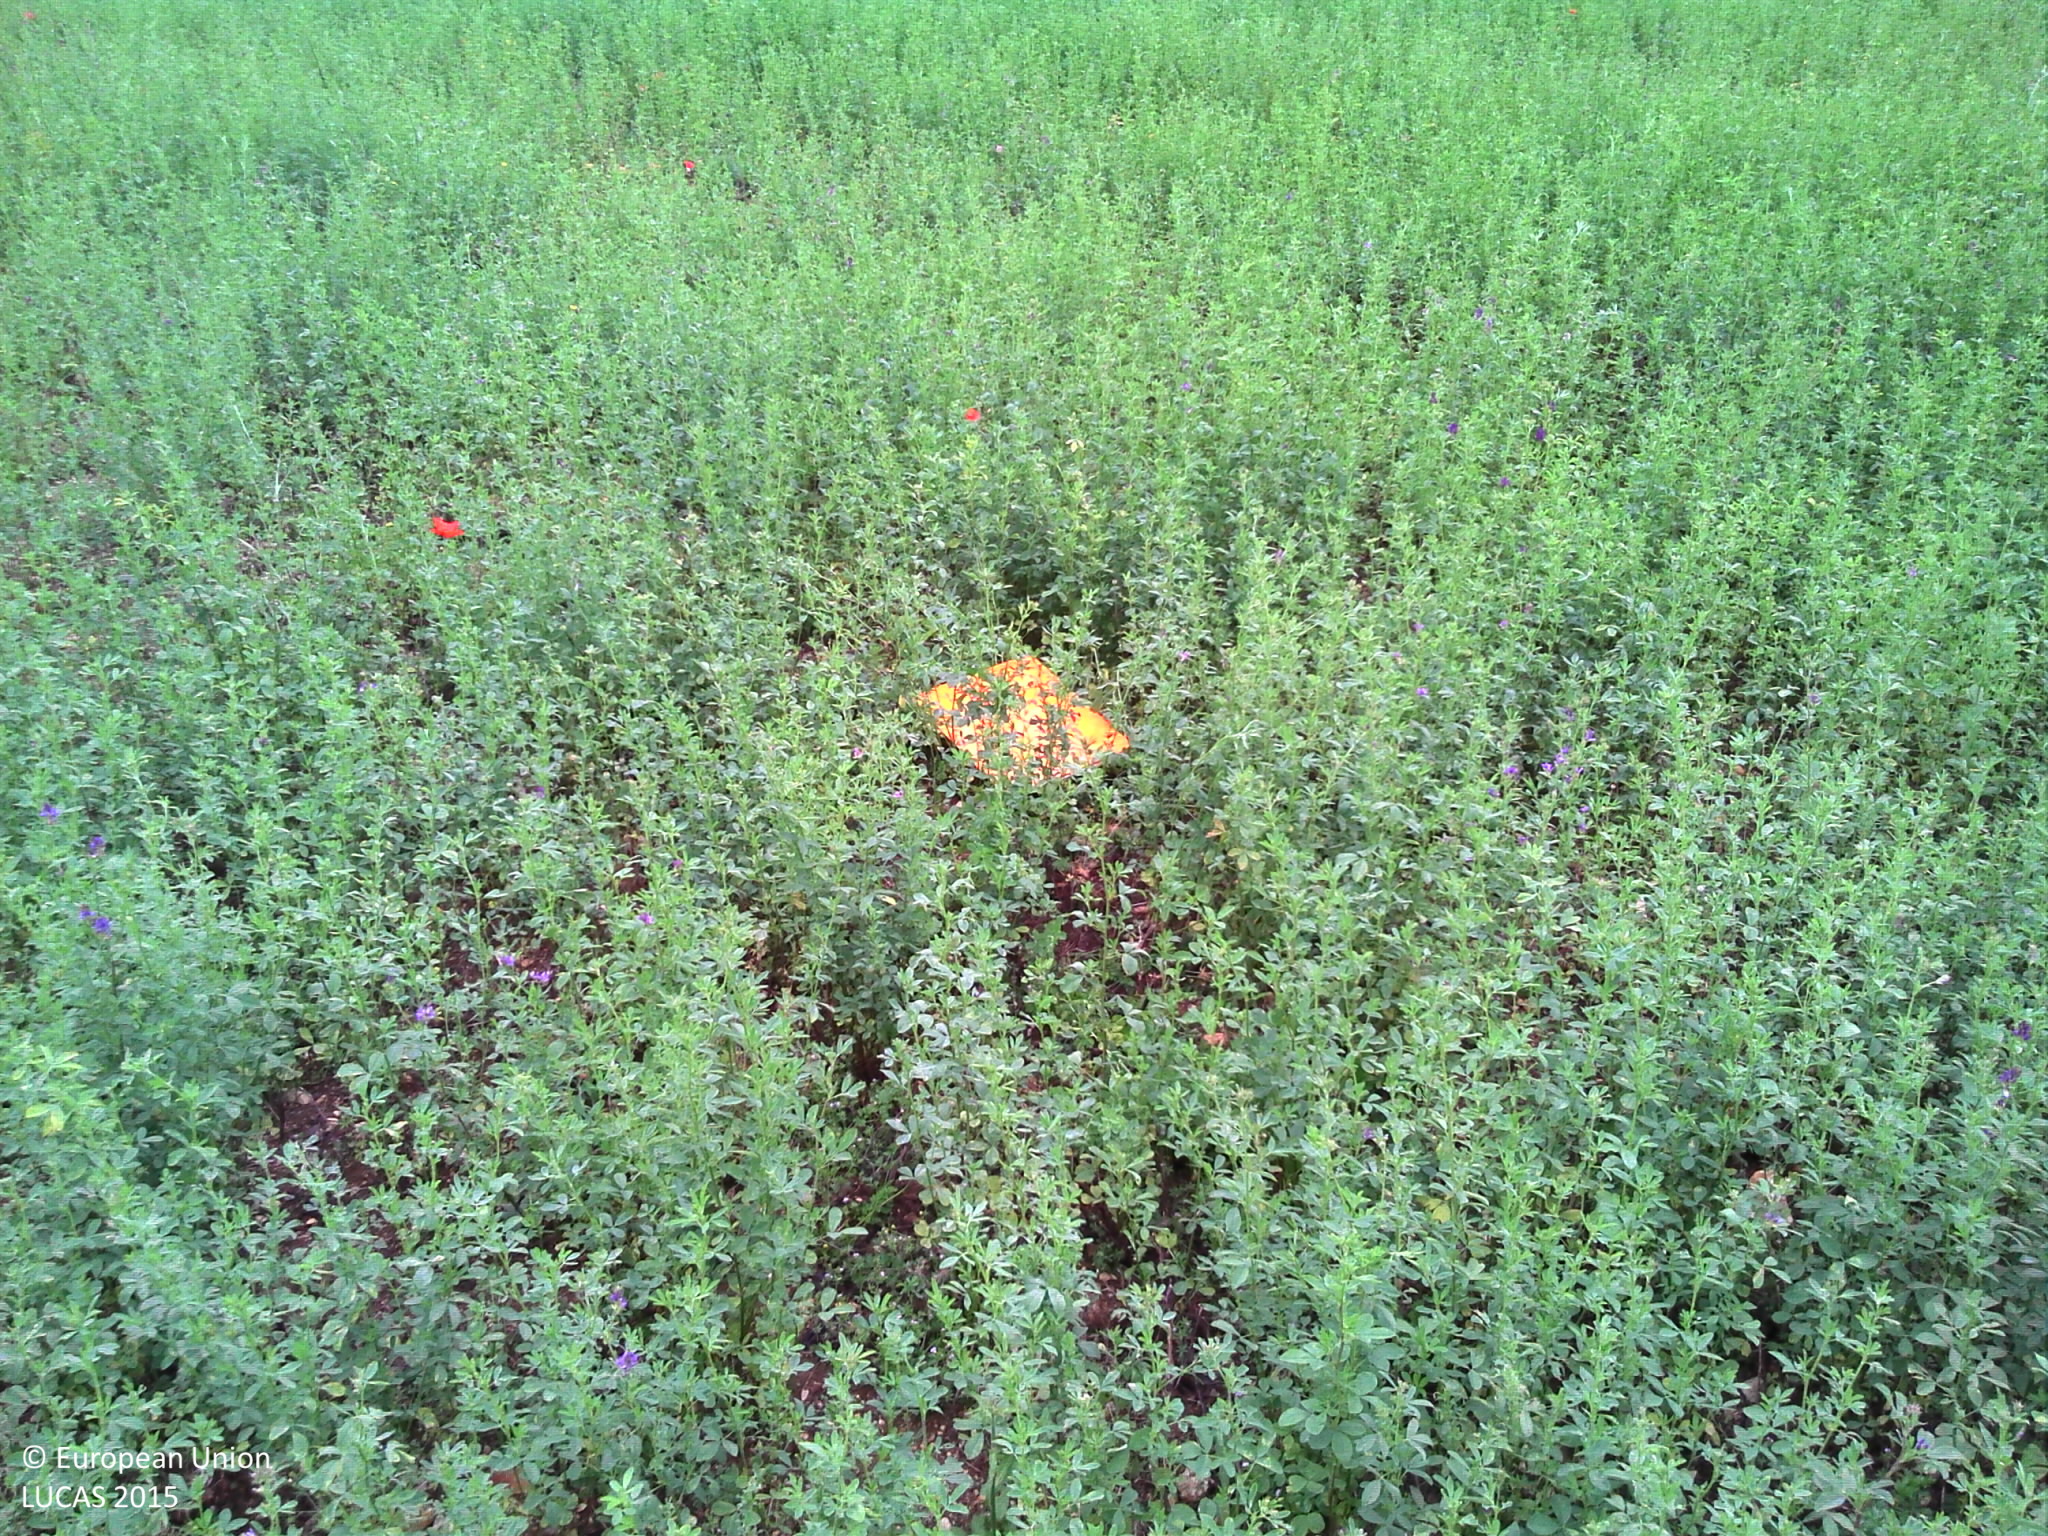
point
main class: Cropland
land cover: Lucerne
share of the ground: > 75 %
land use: Agriculture (excluding fallow land and kitchen gardens)
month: June
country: FR
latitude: 46.5596
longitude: 0.4727
